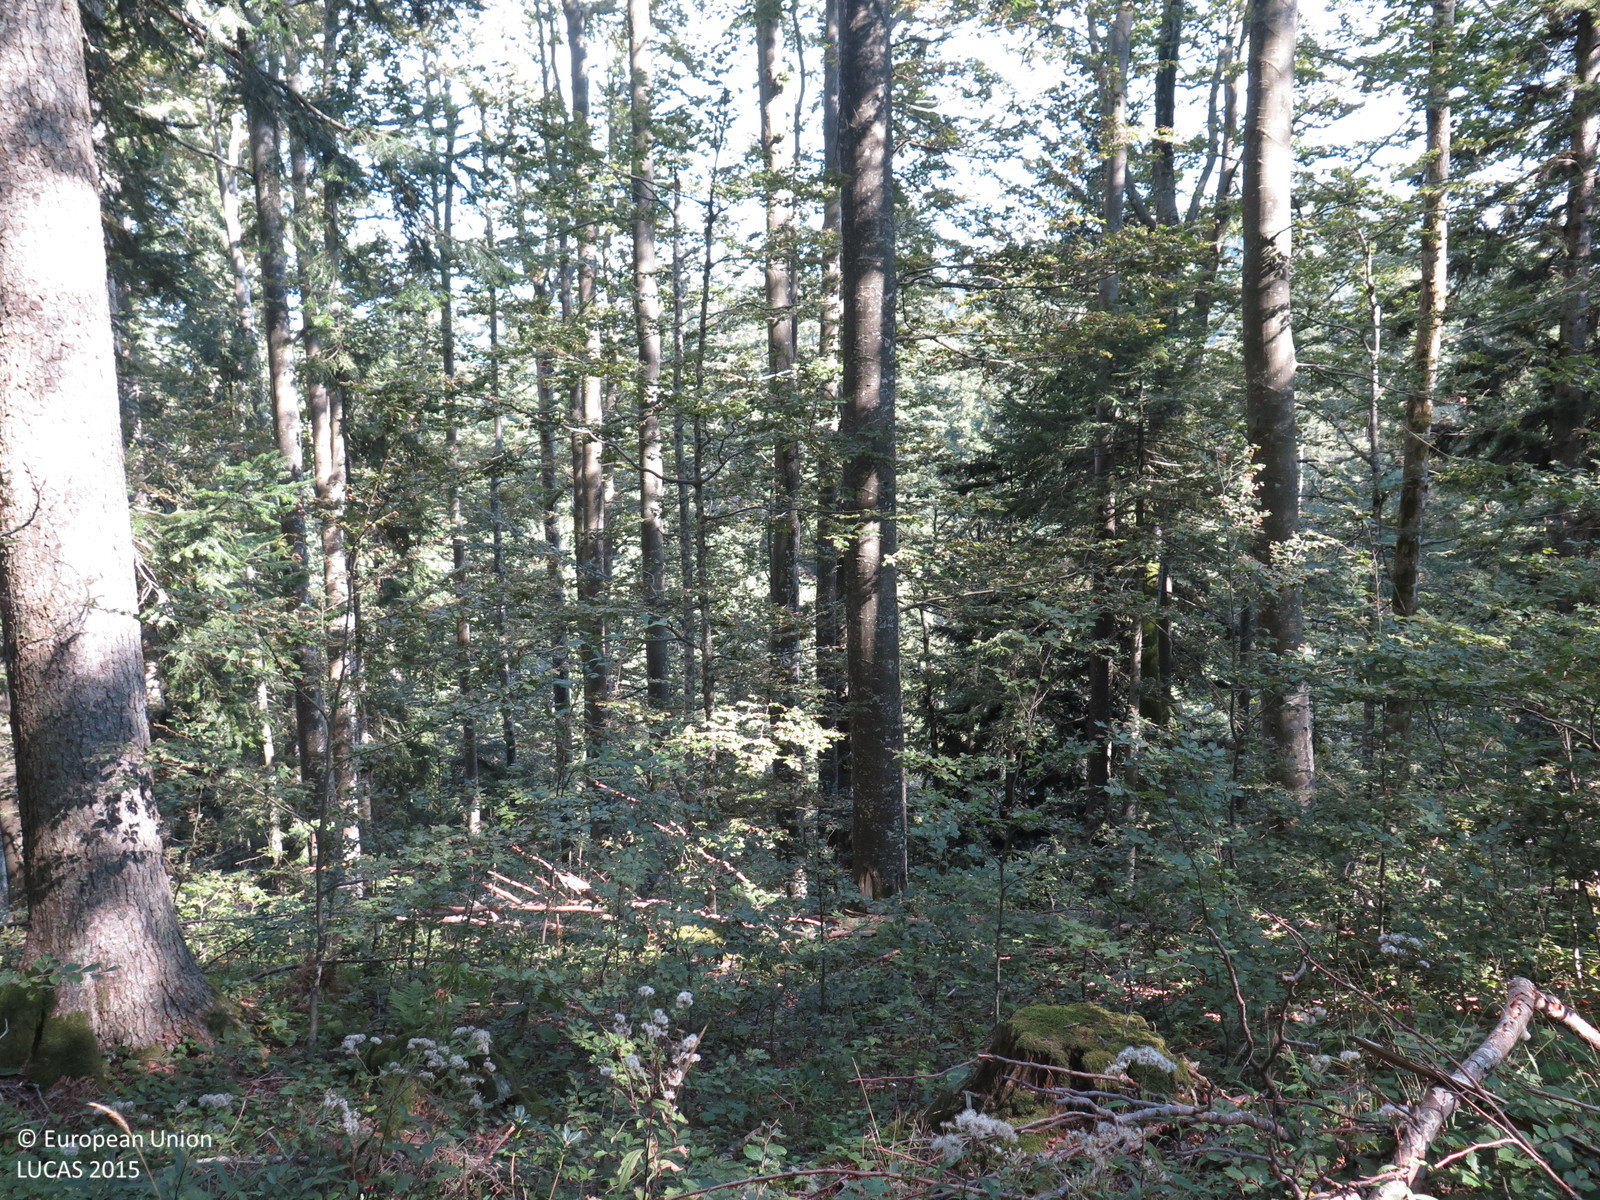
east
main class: Woodland
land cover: Other mixed woodland
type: alpine coniferous forest
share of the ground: > 75 %
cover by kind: coniferous forest trees 75 %, broadleaved forest trees 25 %
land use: Forestry
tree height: > 5 m
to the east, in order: Other mixed woodland
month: September
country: HR
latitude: 45.3982
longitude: 14.7346
